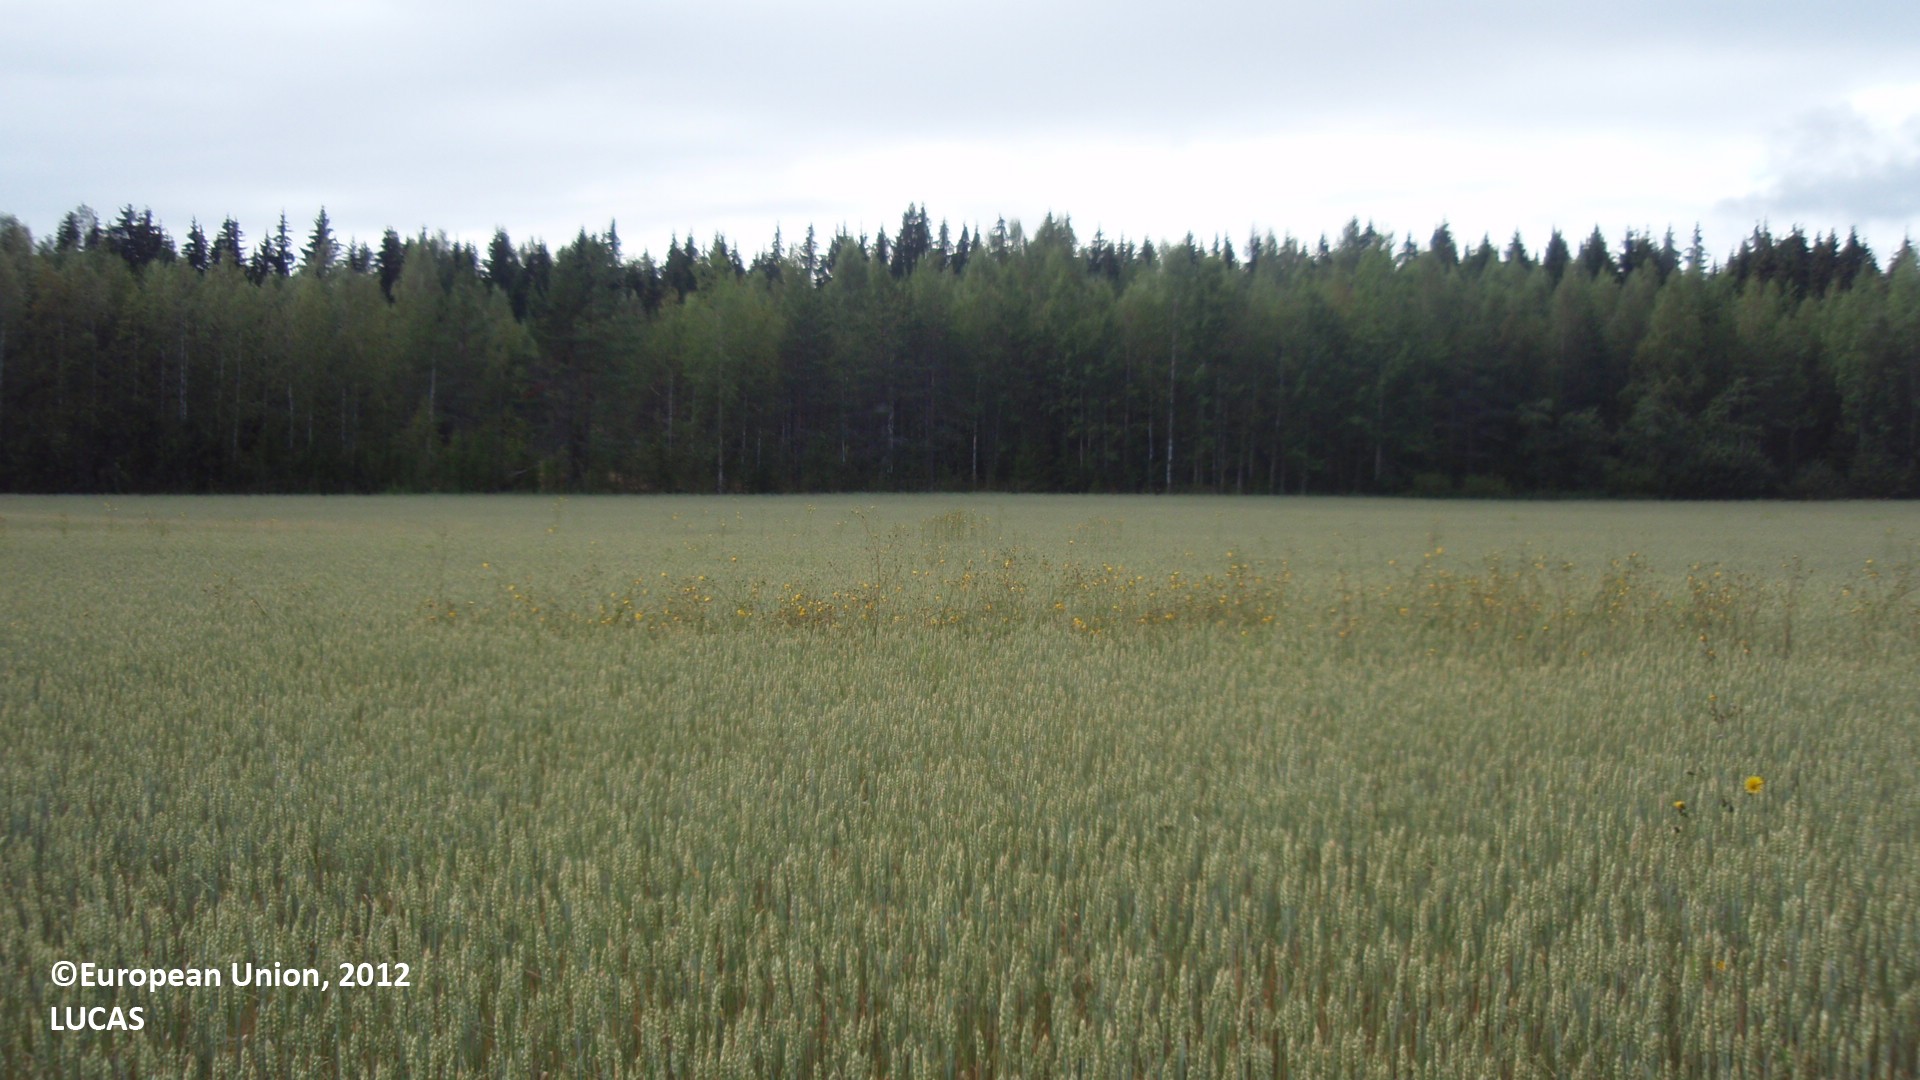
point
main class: Cropland
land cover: Common wheat
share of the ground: > 75 %
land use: Agriculture (excluding fallow land and kitchen gardens)
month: August
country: FI
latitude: 61.0766
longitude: 27.0151
